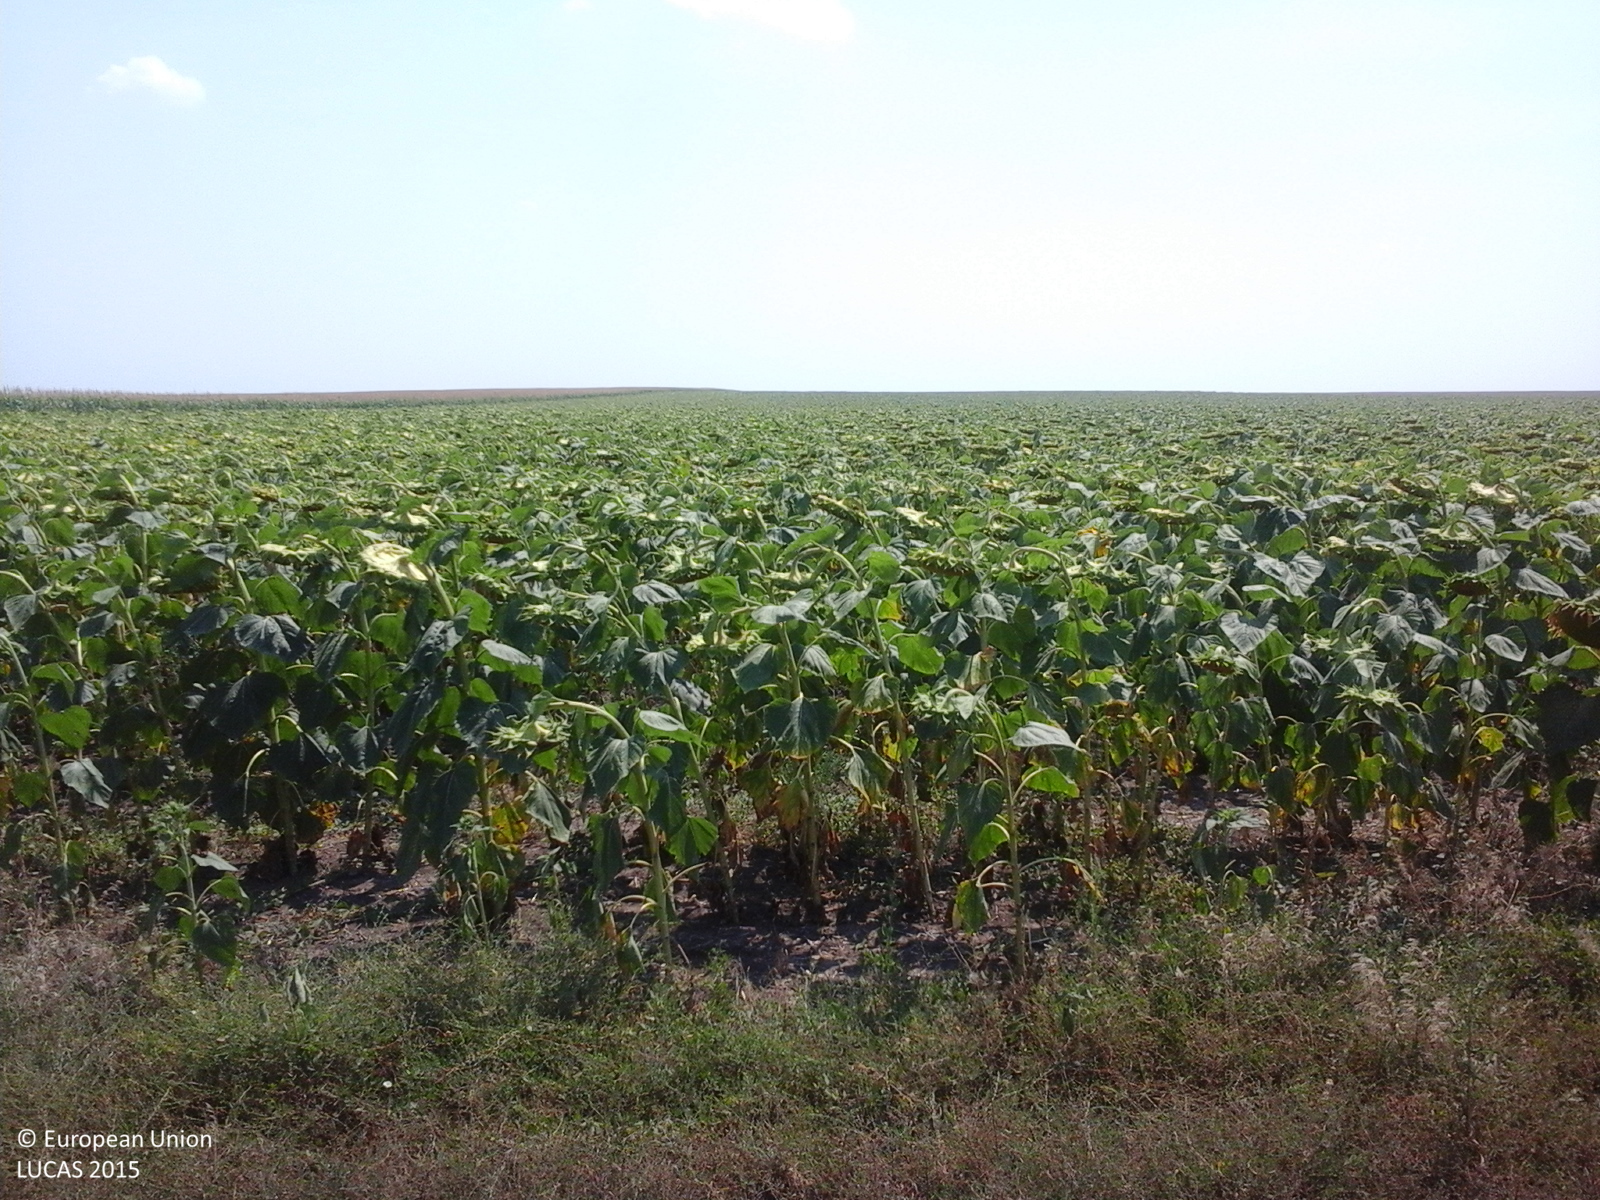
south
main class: Cropland
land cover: Maize
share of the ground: > 75 %
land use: Agriculture (excluding fallow land and kitchen gardens)
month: July
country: RO
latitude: 45.9339
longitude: 27.5576
